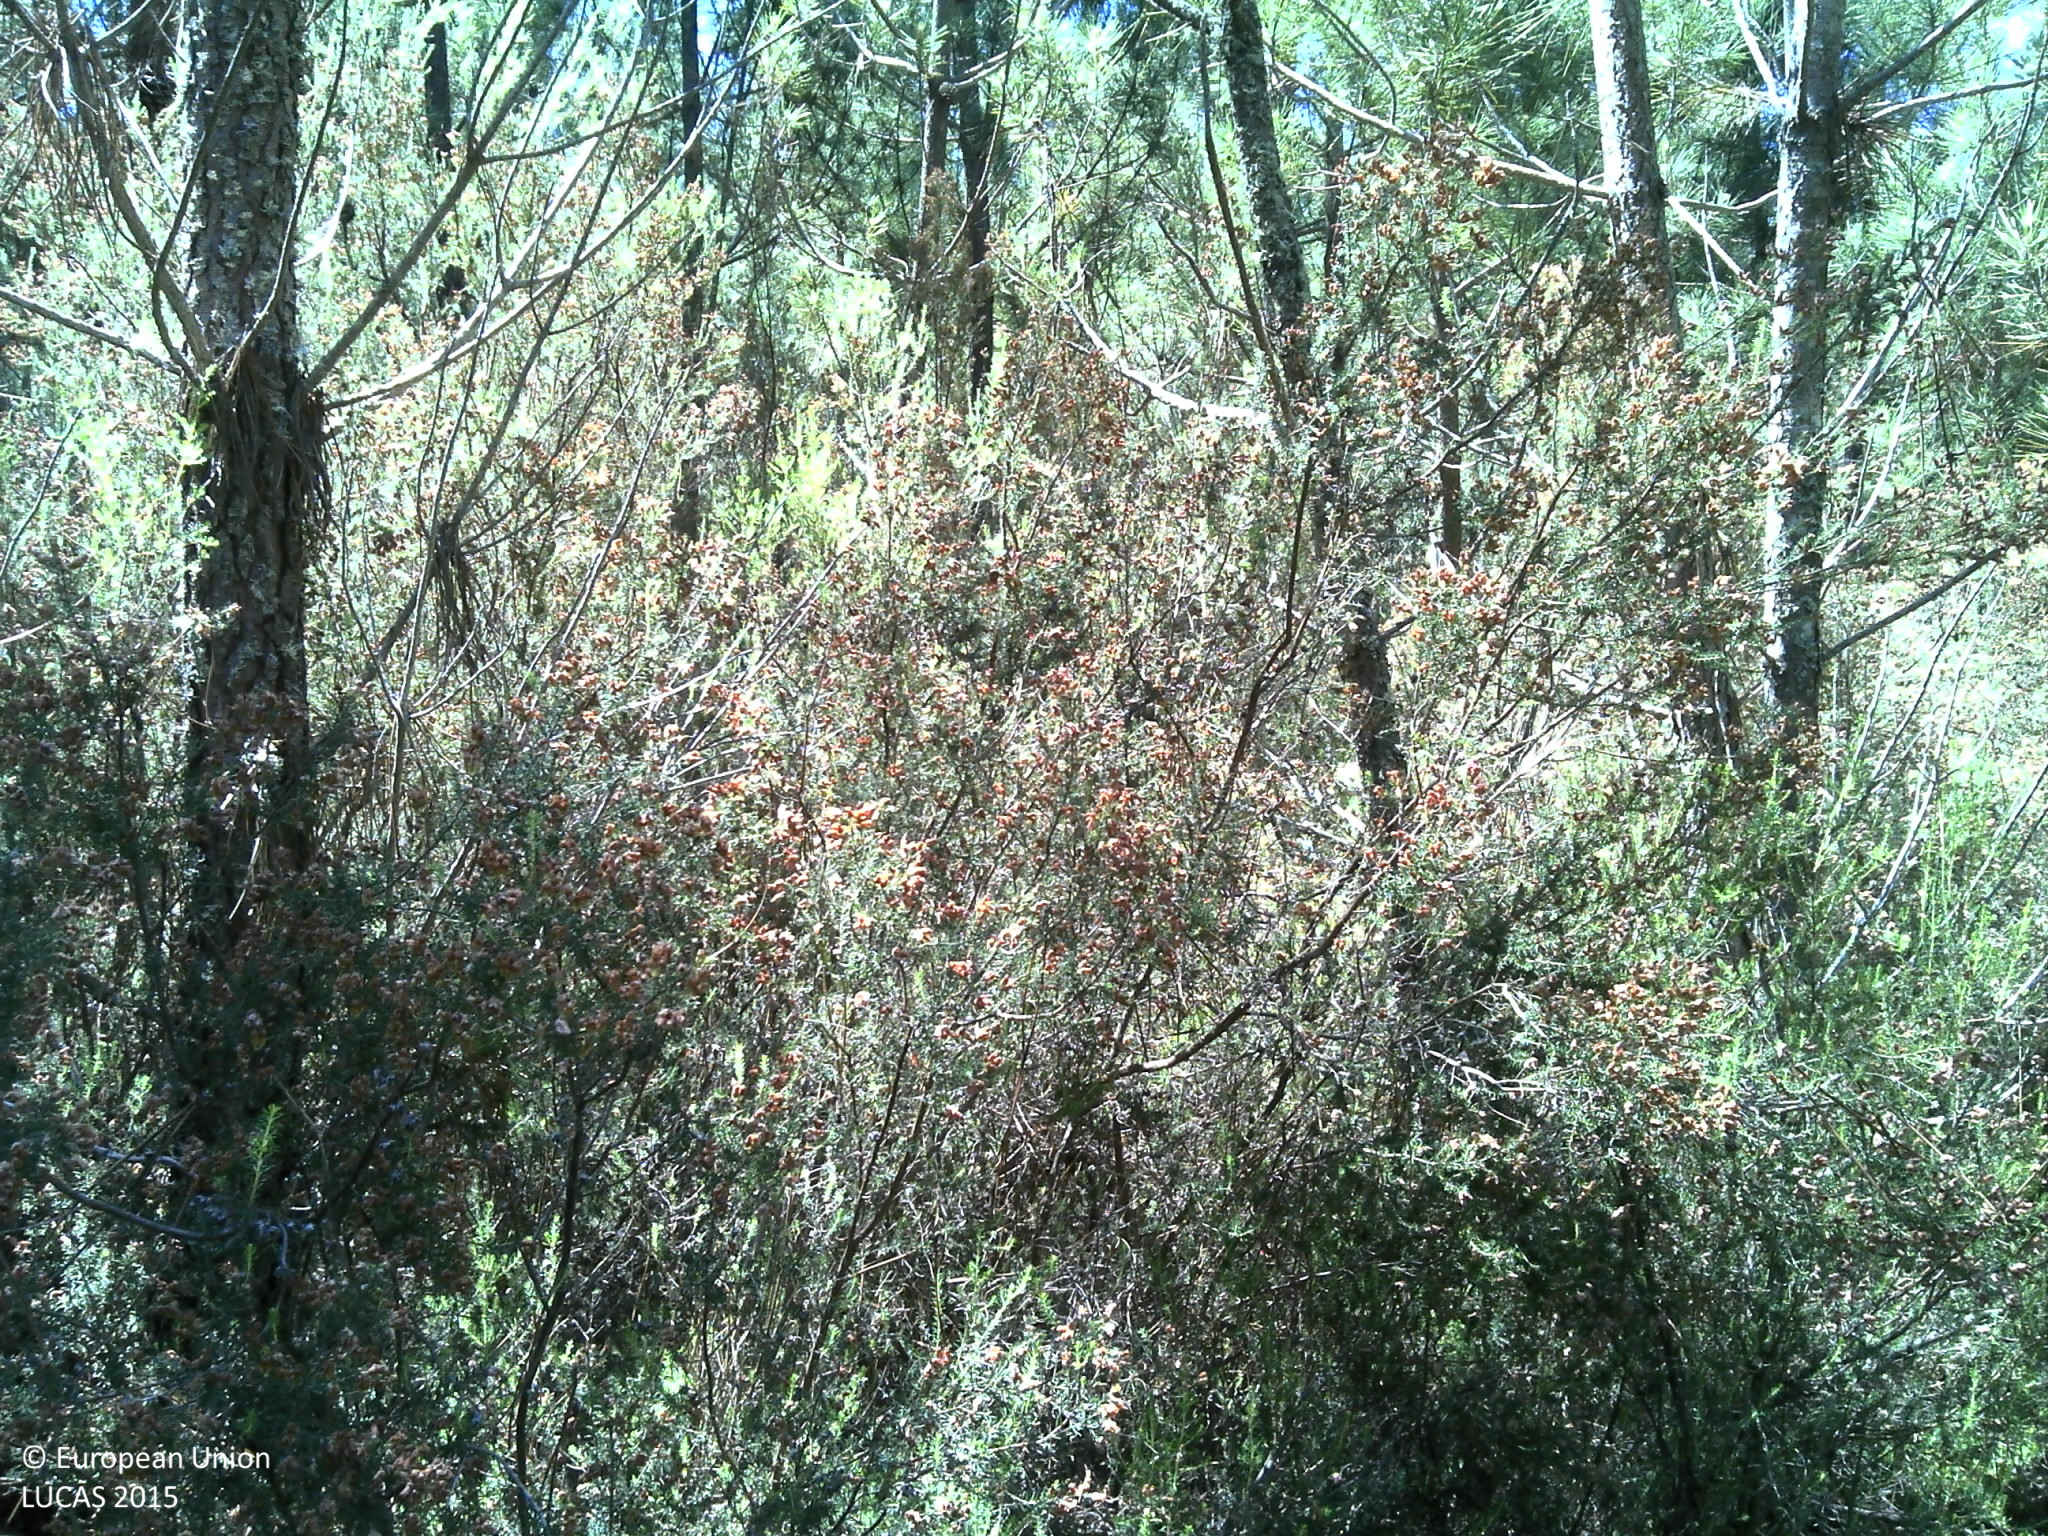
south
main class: Woodland
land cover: Pine dominated coniferous woodland
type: coniferous forest of the mediterranean region
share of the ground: > 75 %
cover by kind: coniferous forest trees 75 %, shrubs 20 %
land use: Forestry
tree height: > 5 m
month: June
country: PT
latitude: 40.9299
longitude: -7.6143
